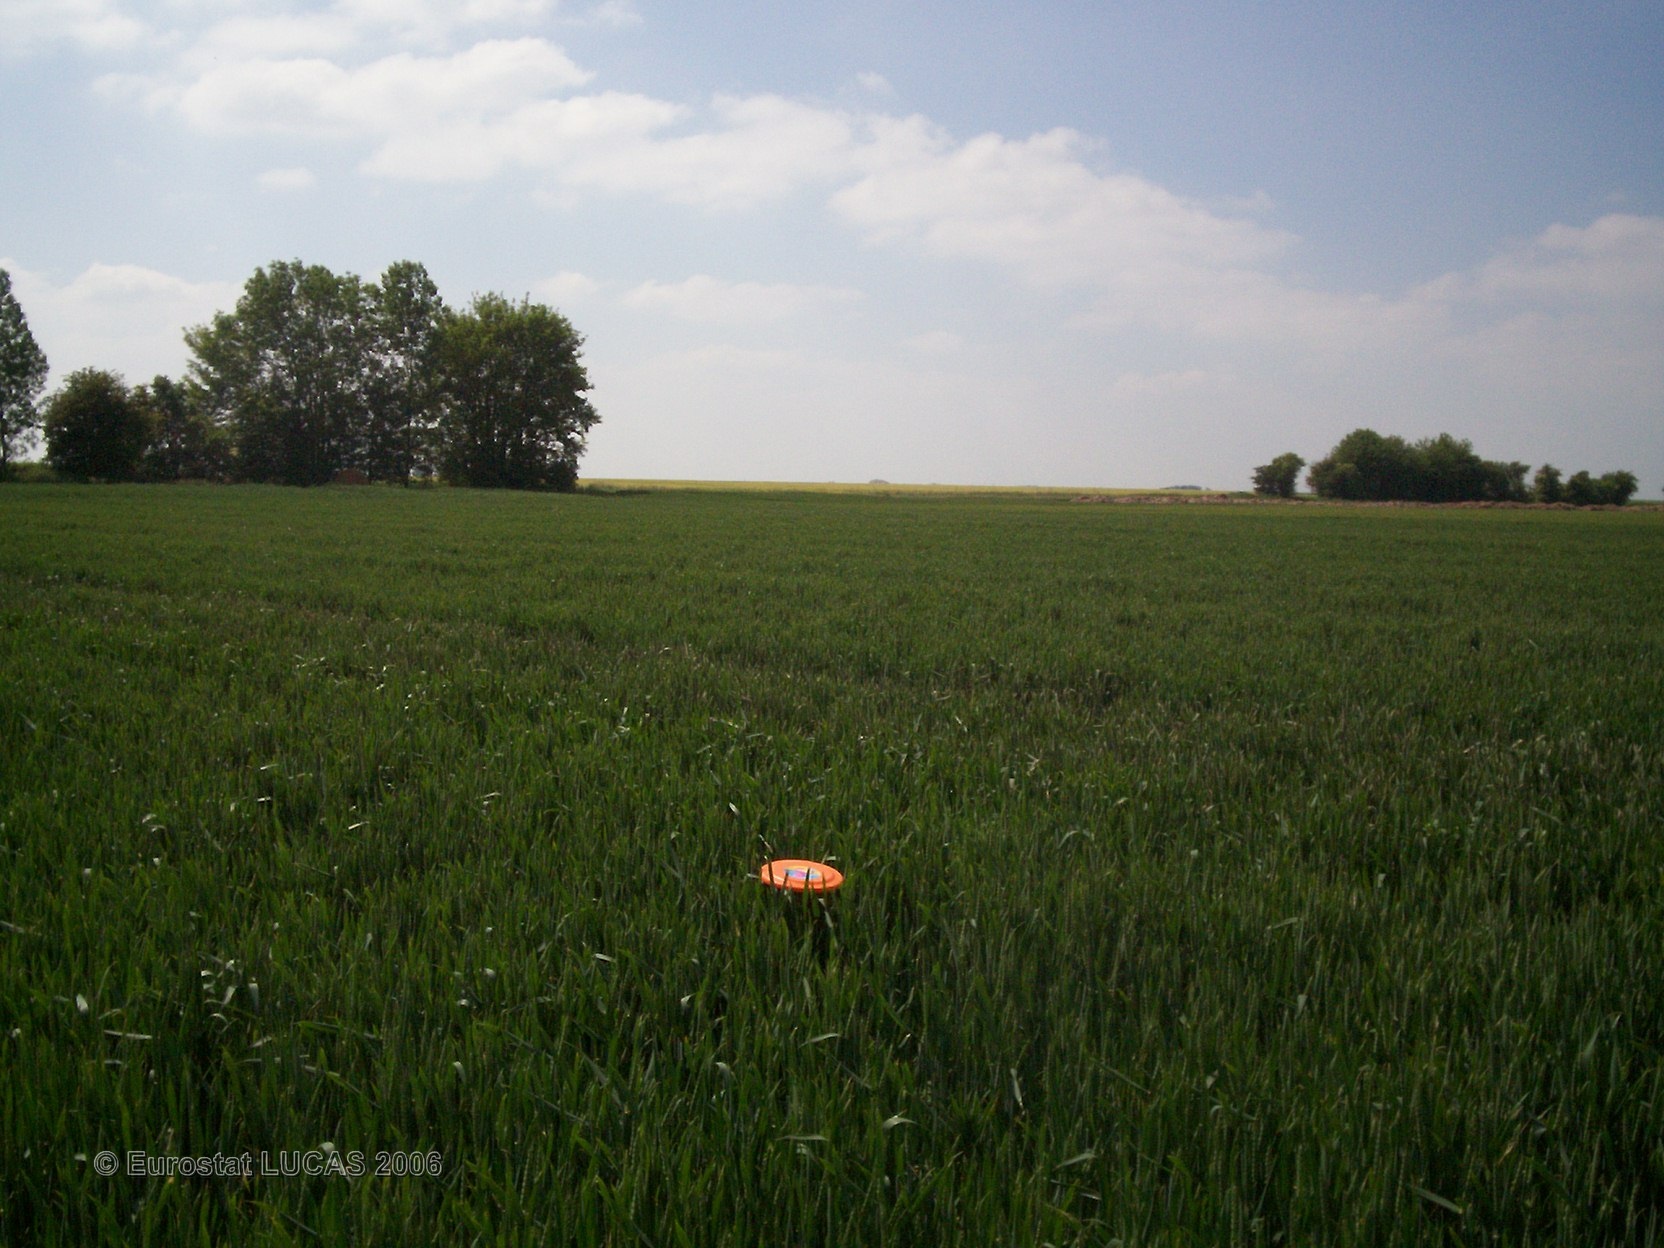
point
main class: Cropland
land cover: Common wheat
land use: Agriculture (excluding fallow land and kitchen gardens)
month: June
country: FR
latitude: 49.7856
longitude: 2.6690
